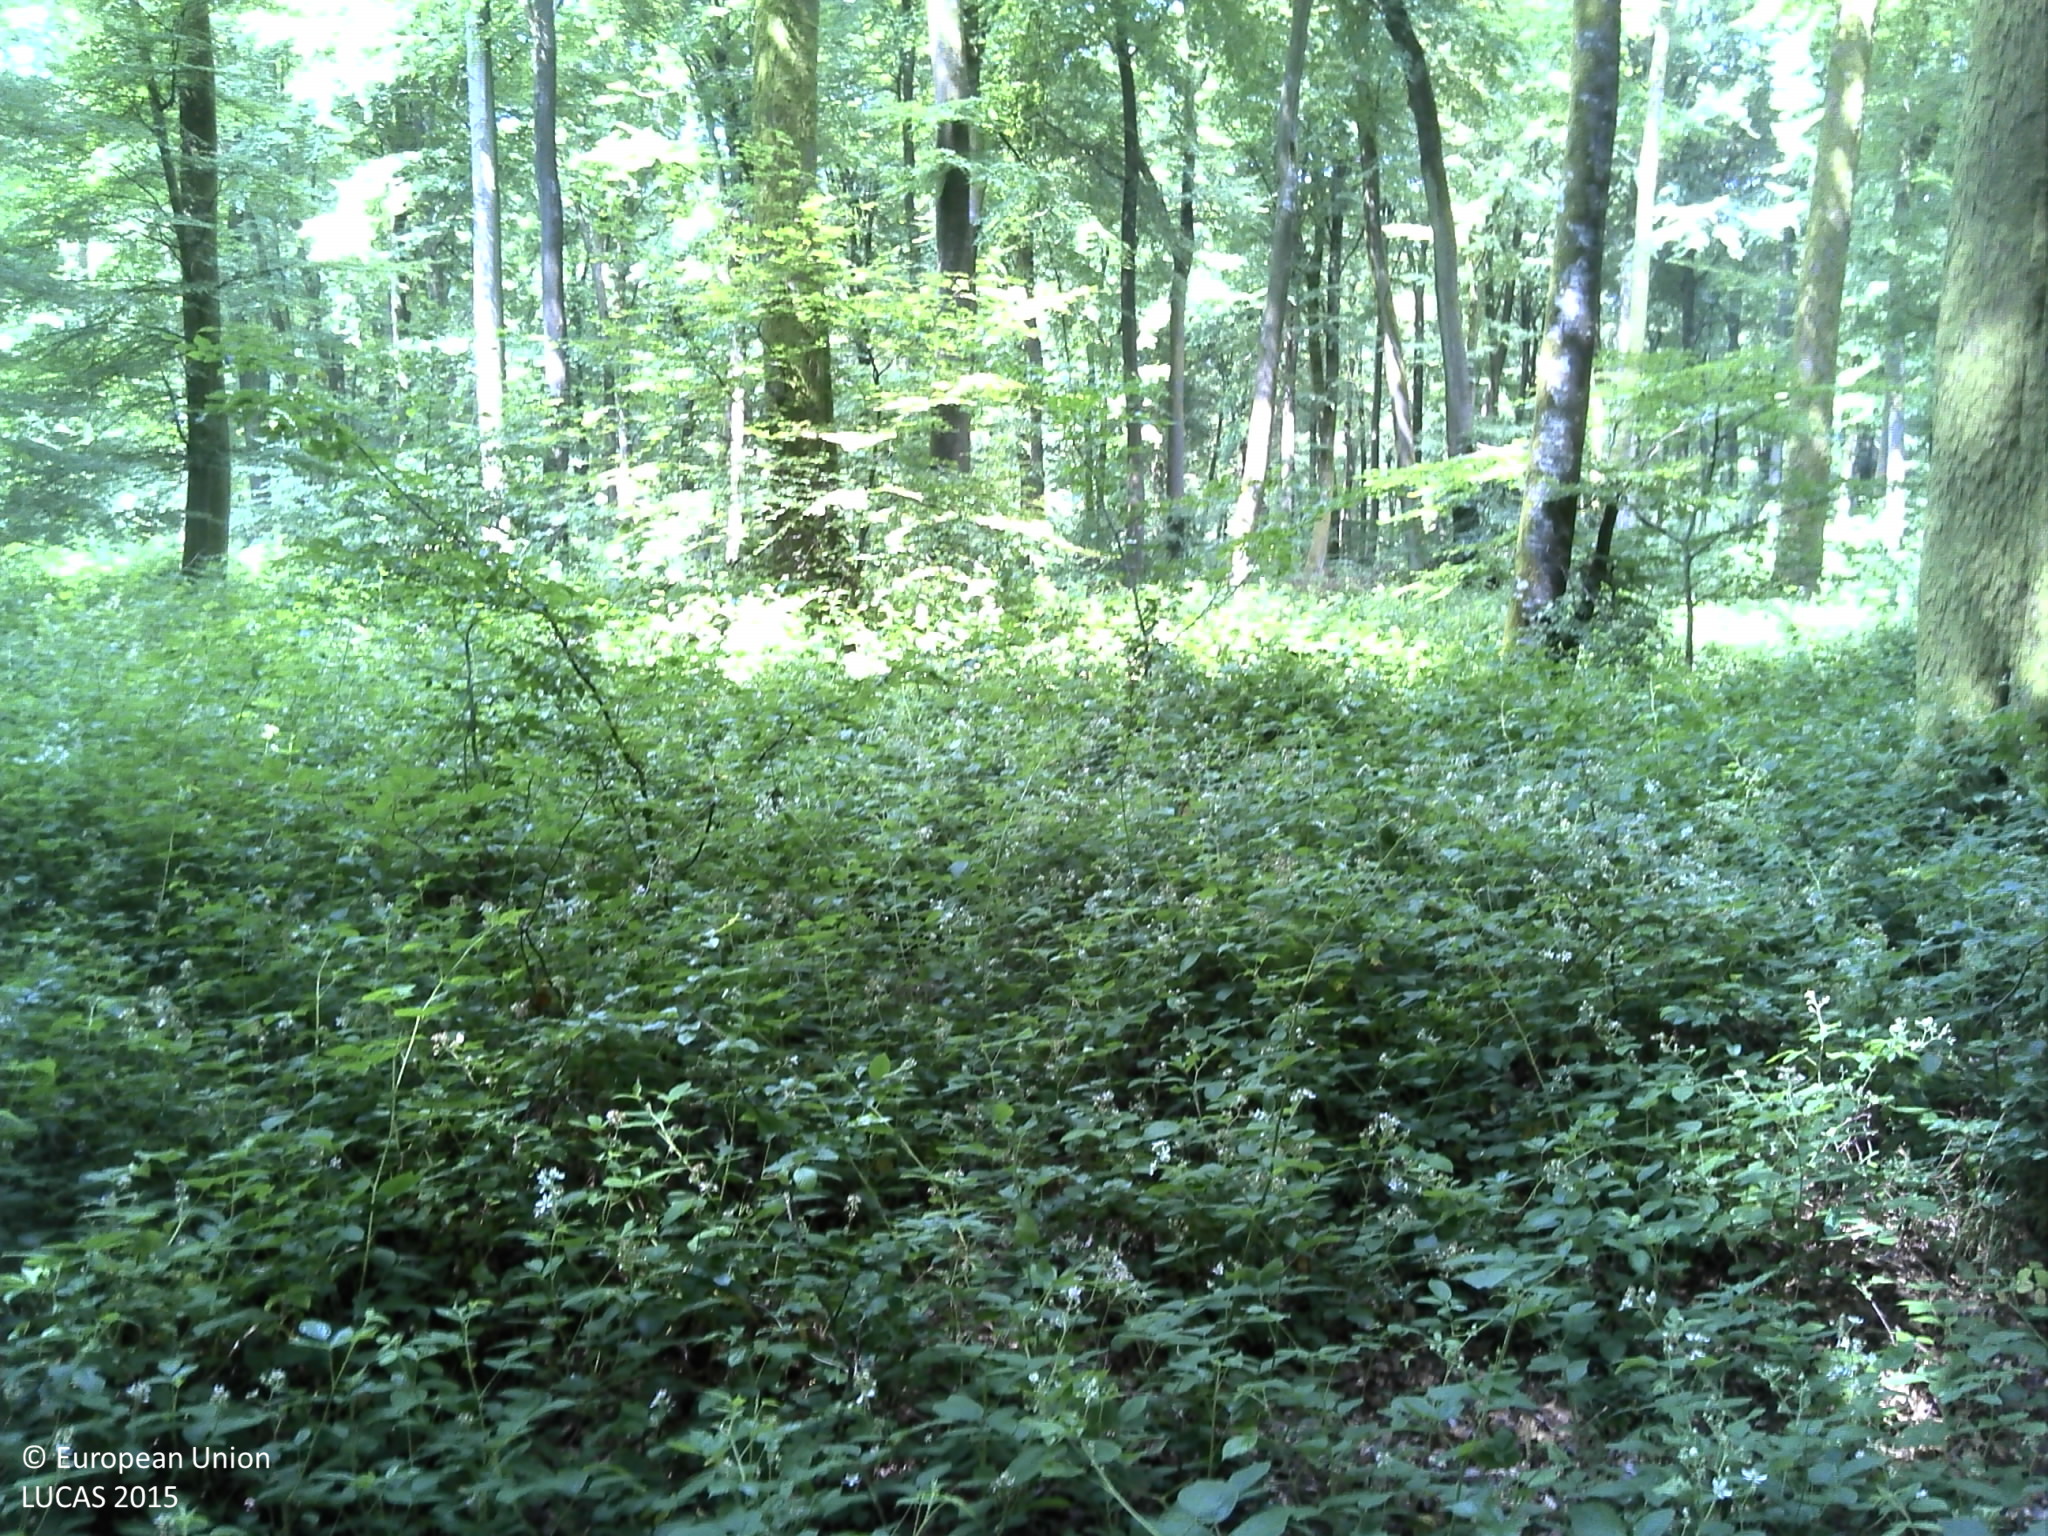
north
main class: Woodland
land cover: Broadleaved woodland
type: beech forest
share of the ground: > 75 %
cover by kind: broadleaved forest trees 100 %
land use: Forestry
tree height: > 5 m
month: July
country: FR
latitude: 49.8931
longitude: 1.6160
